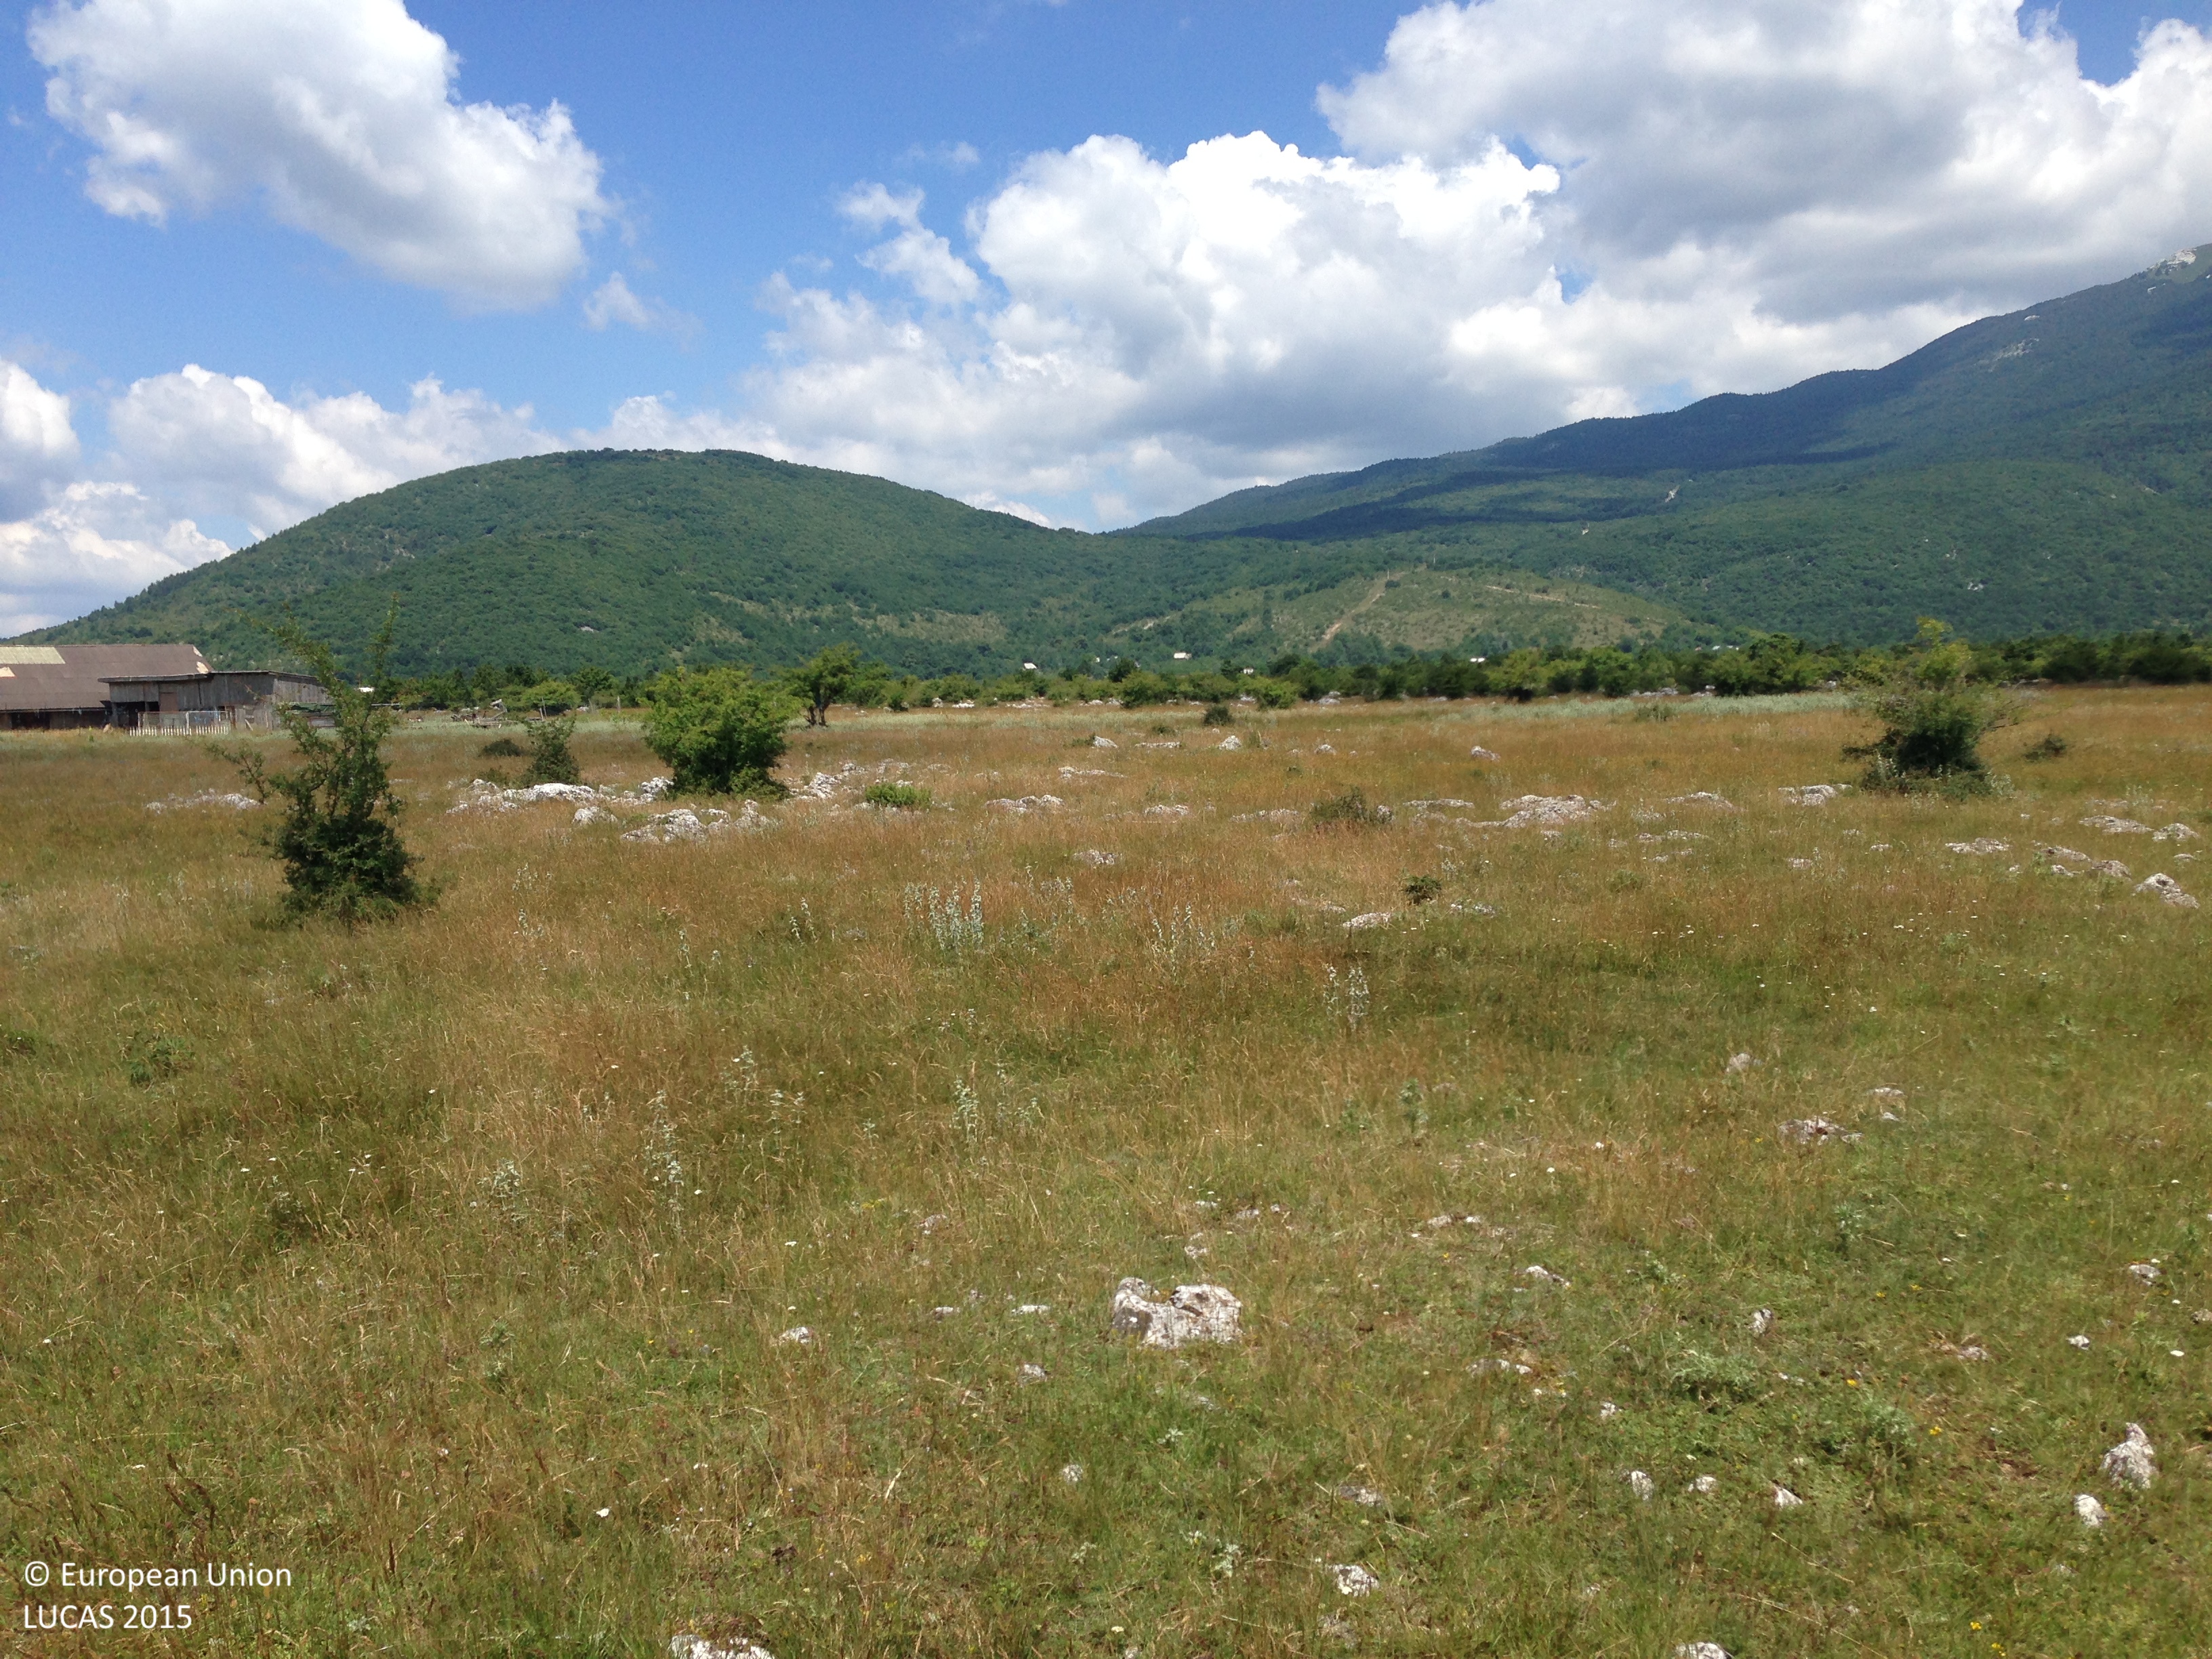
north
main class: Grassland
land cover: Grassland with sparse tree/shrub cover
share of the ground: > 75 %
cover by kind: herbaceous plants 65 %, unconsolidated bare surface 15 %, consolidated bare surface 10 %, broadleaved forest trees 5 %, shrubs 5 %
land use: Semi-natural and natural areas not in use
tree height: < 5 m
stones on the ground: < 10 %
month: June
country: HR
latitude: 44.7533
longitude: 15.7165
